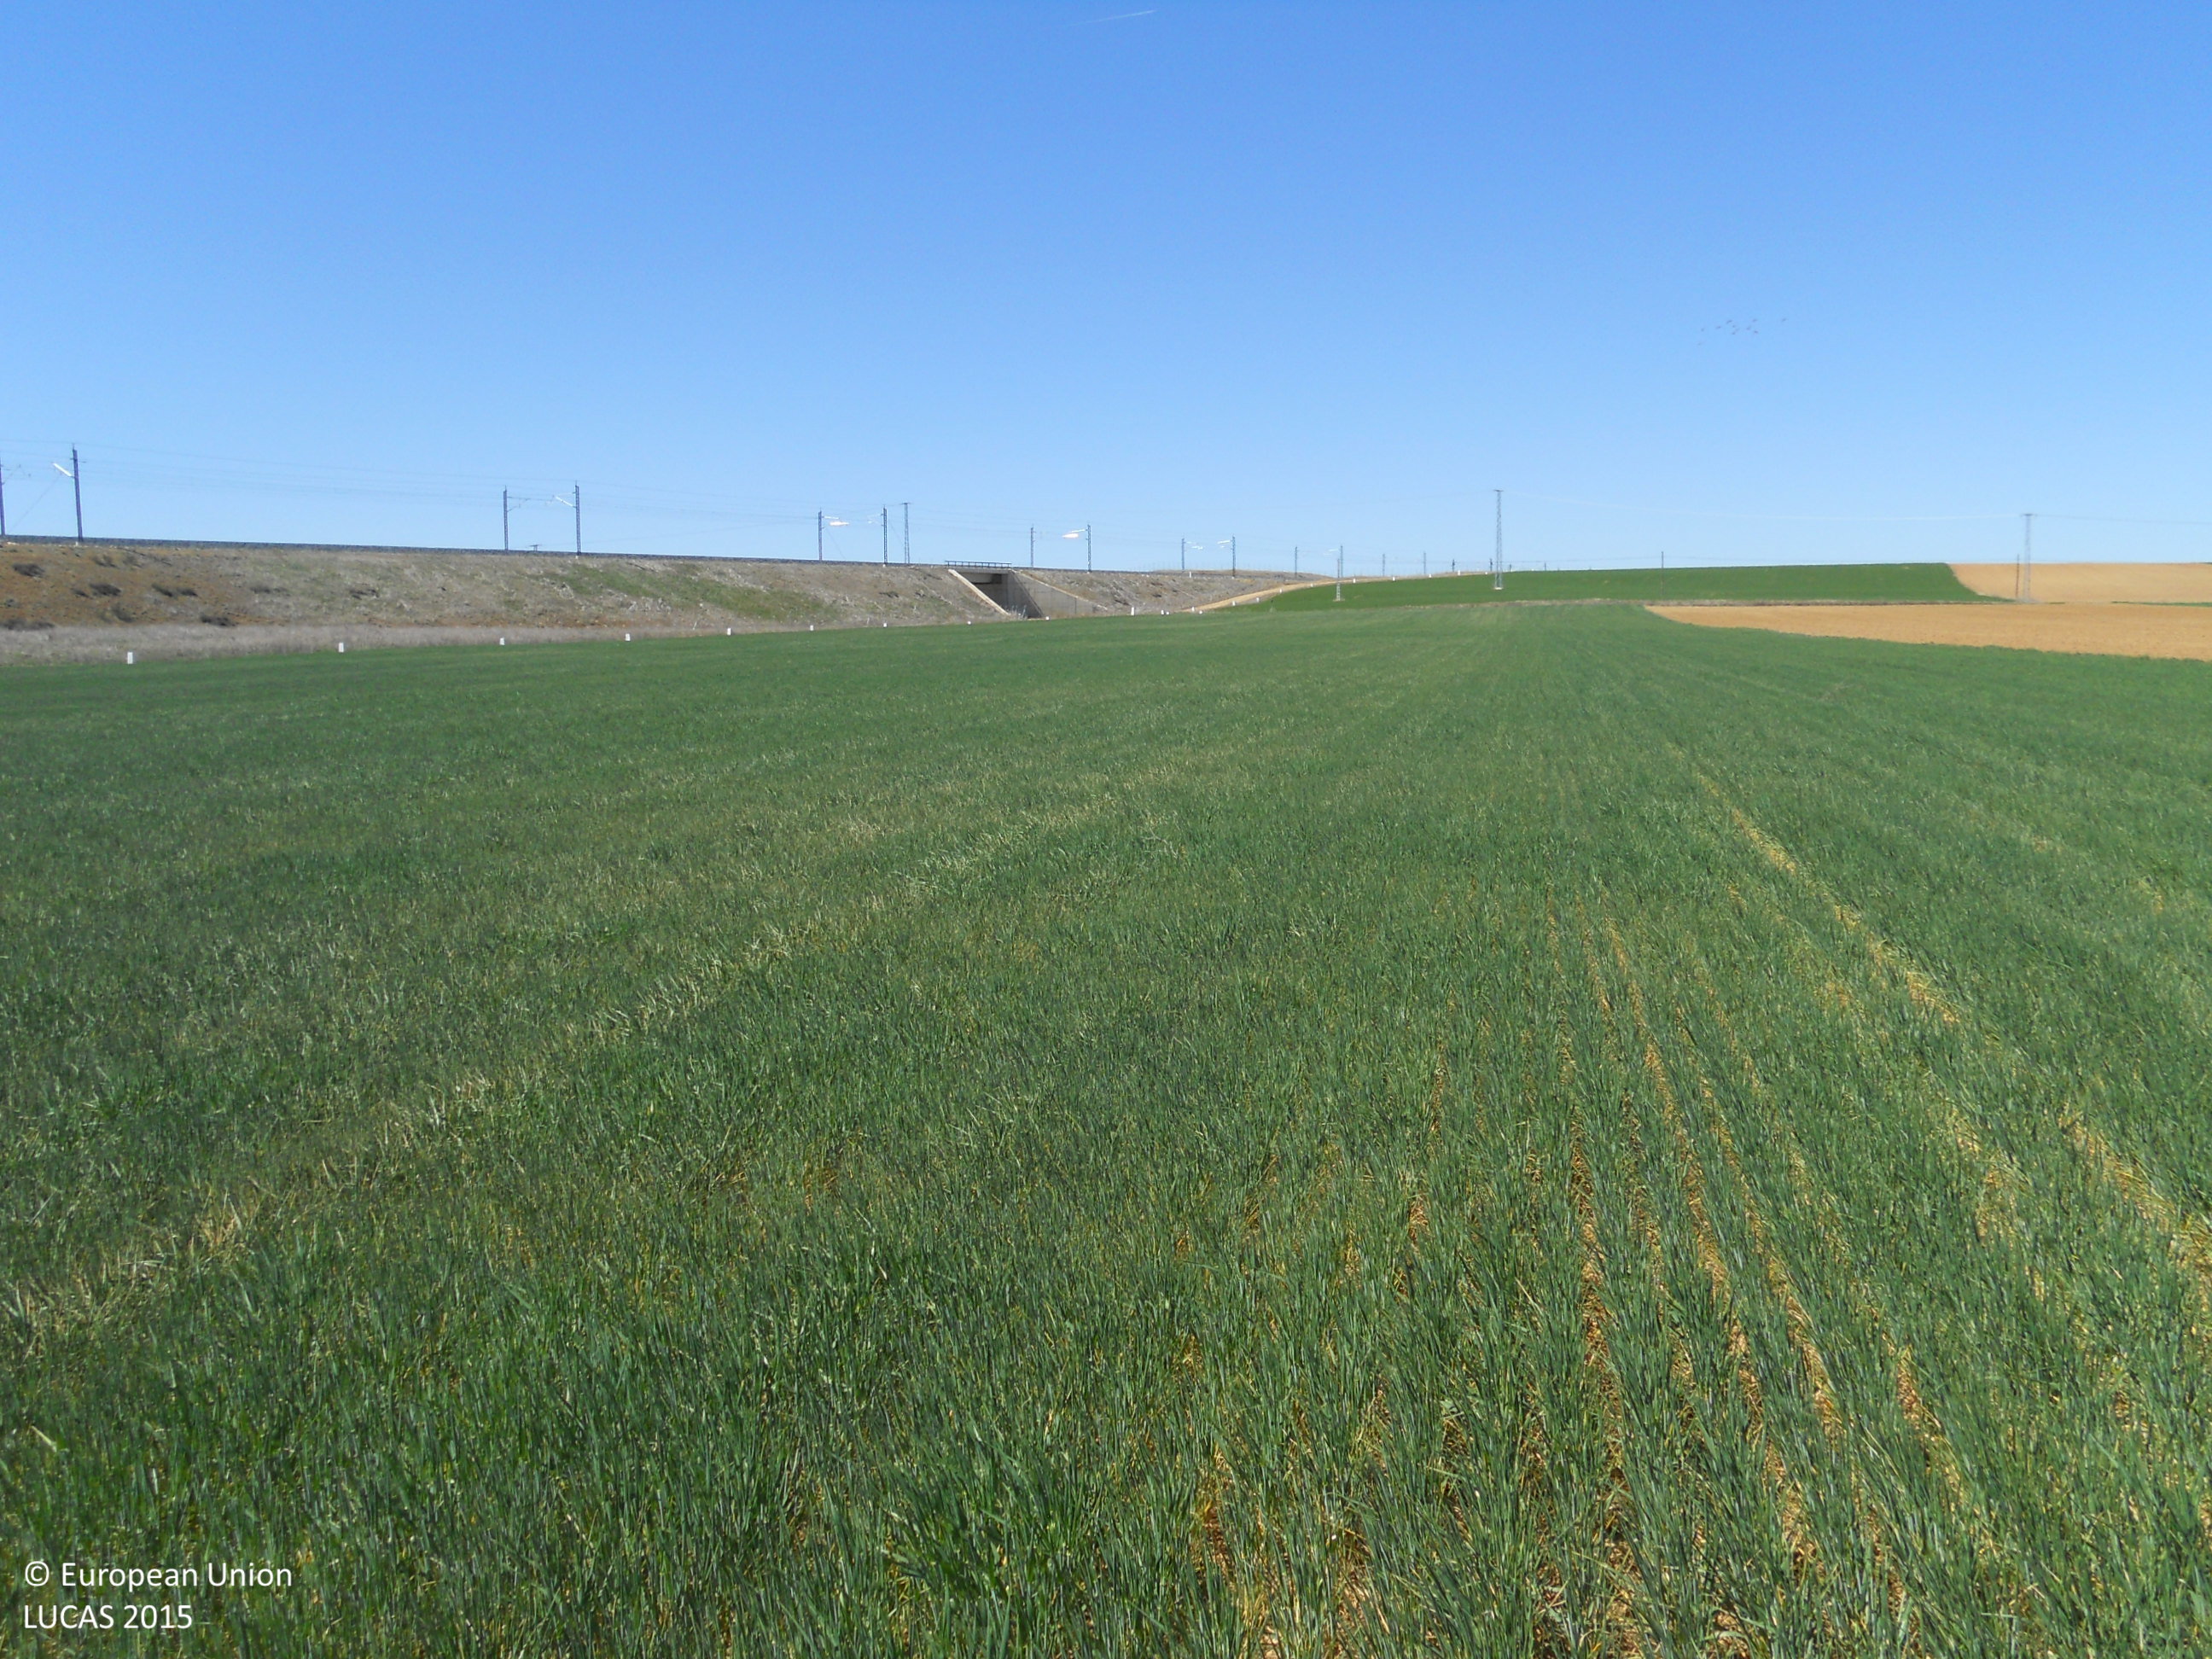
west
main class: Cropland
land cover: Barley
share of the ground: > 75 %
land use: Agriculture (excluding fallow land and kitchen gardens)
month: April
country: ES
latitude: 42.2308
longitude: -4.8487
